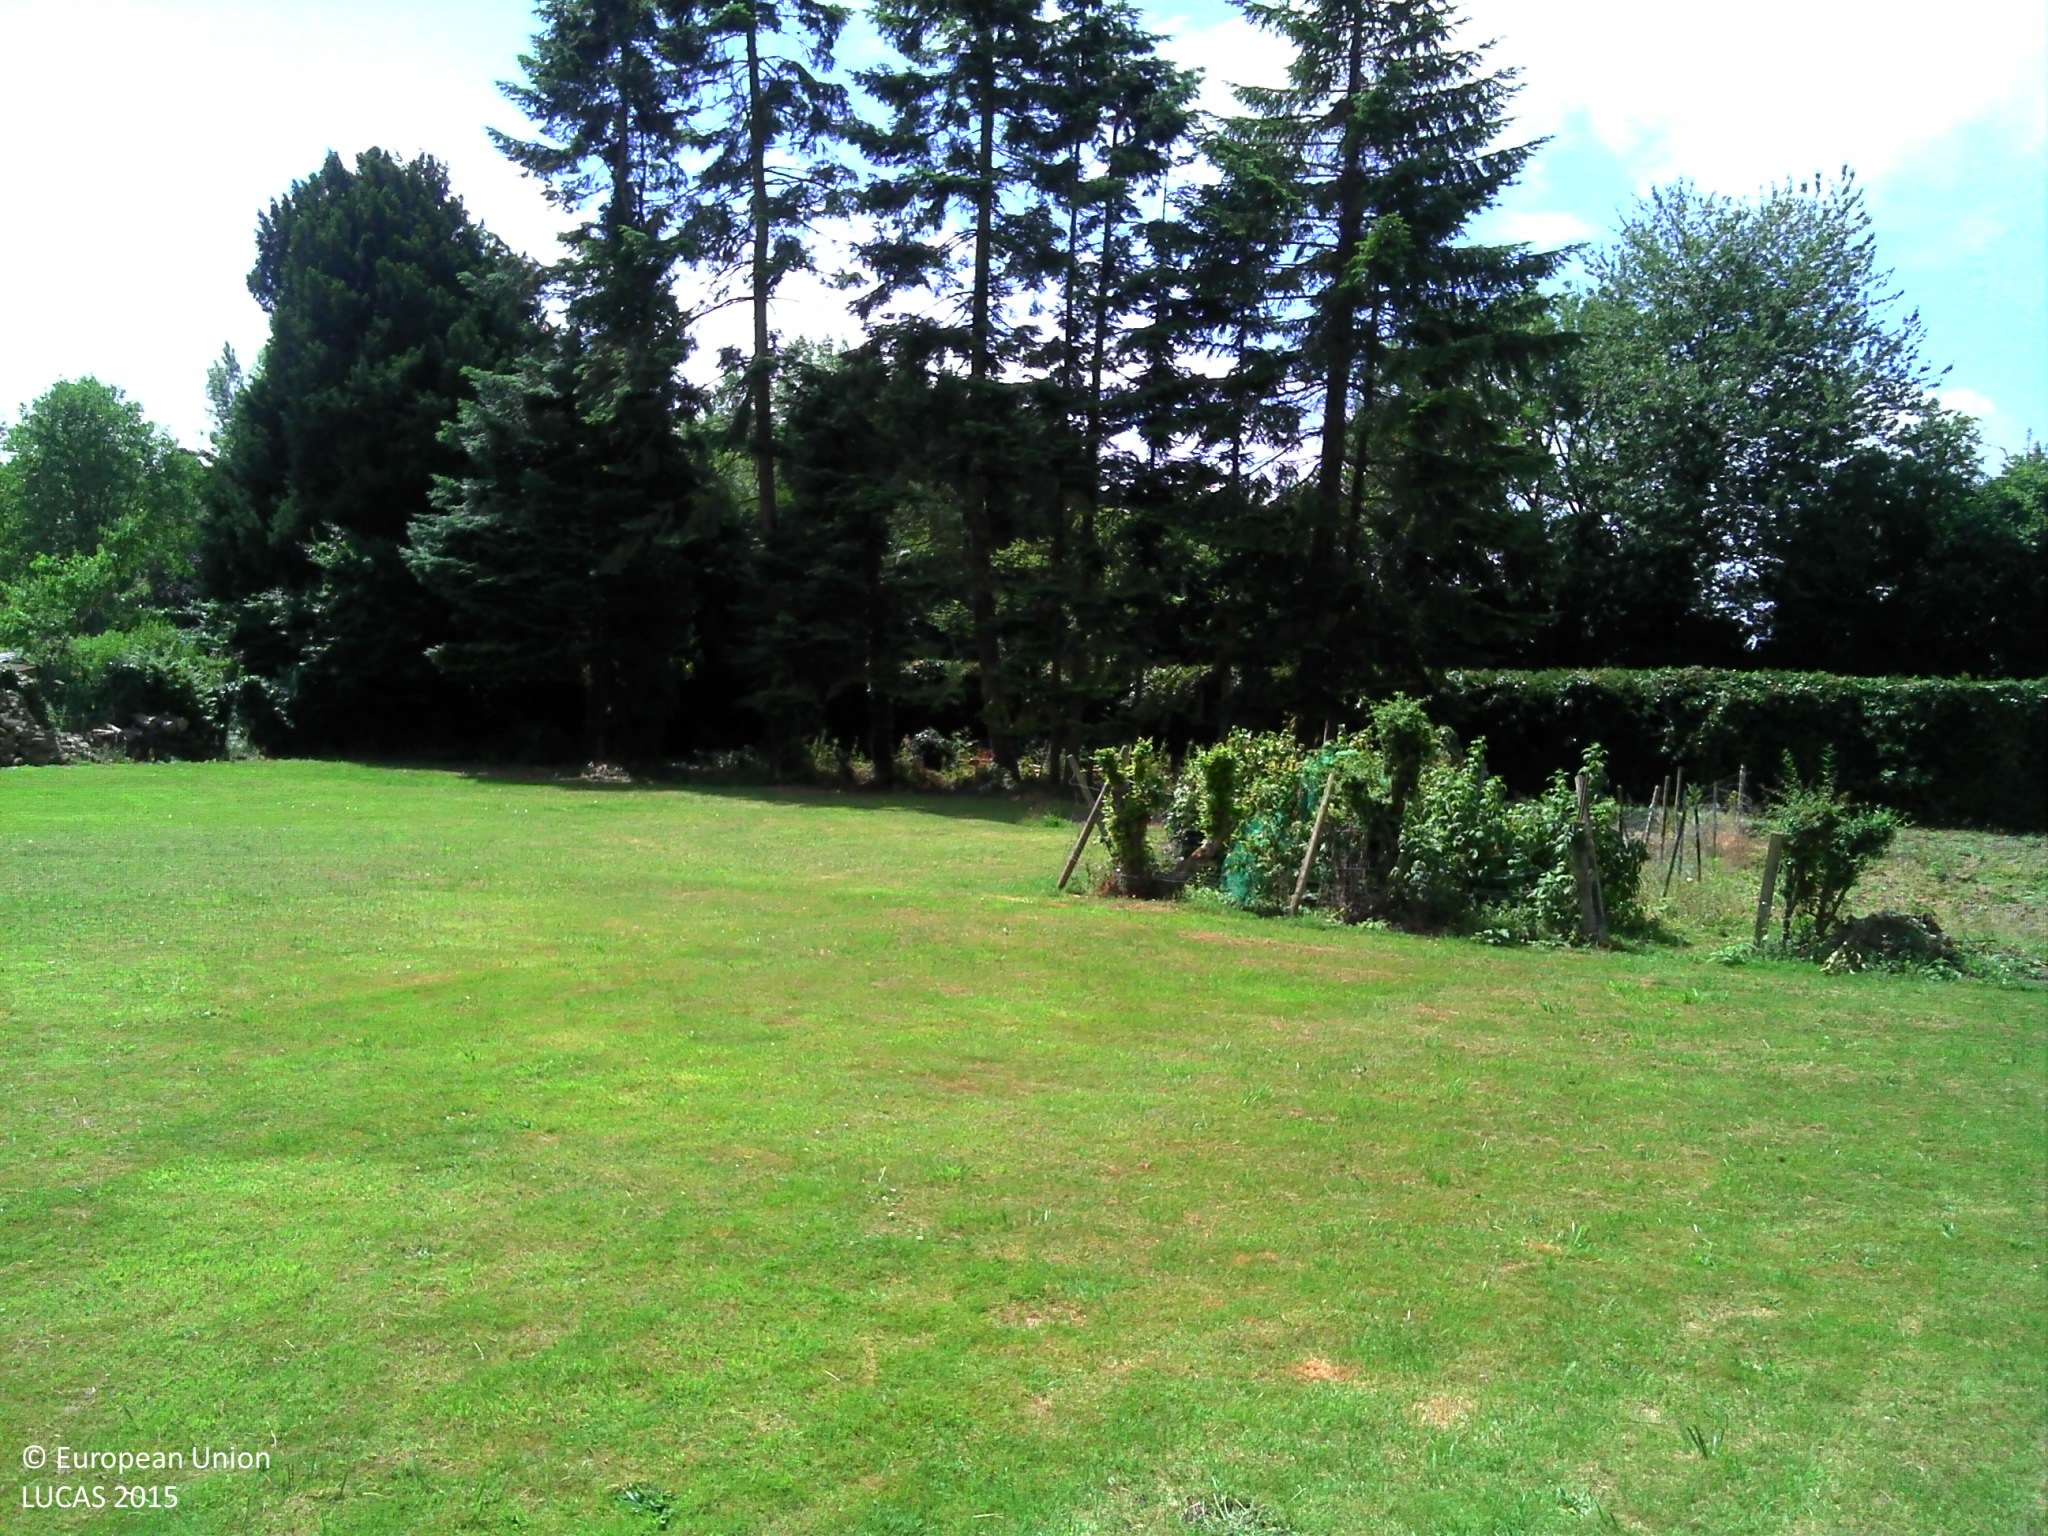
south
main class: Grassland
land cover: Grassland without tree/shrub cover
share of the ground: > 75 %
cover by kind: herbaceous plants 100 %
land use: Residential
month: July
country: FR
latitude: 48.9559
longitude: -0.2899
